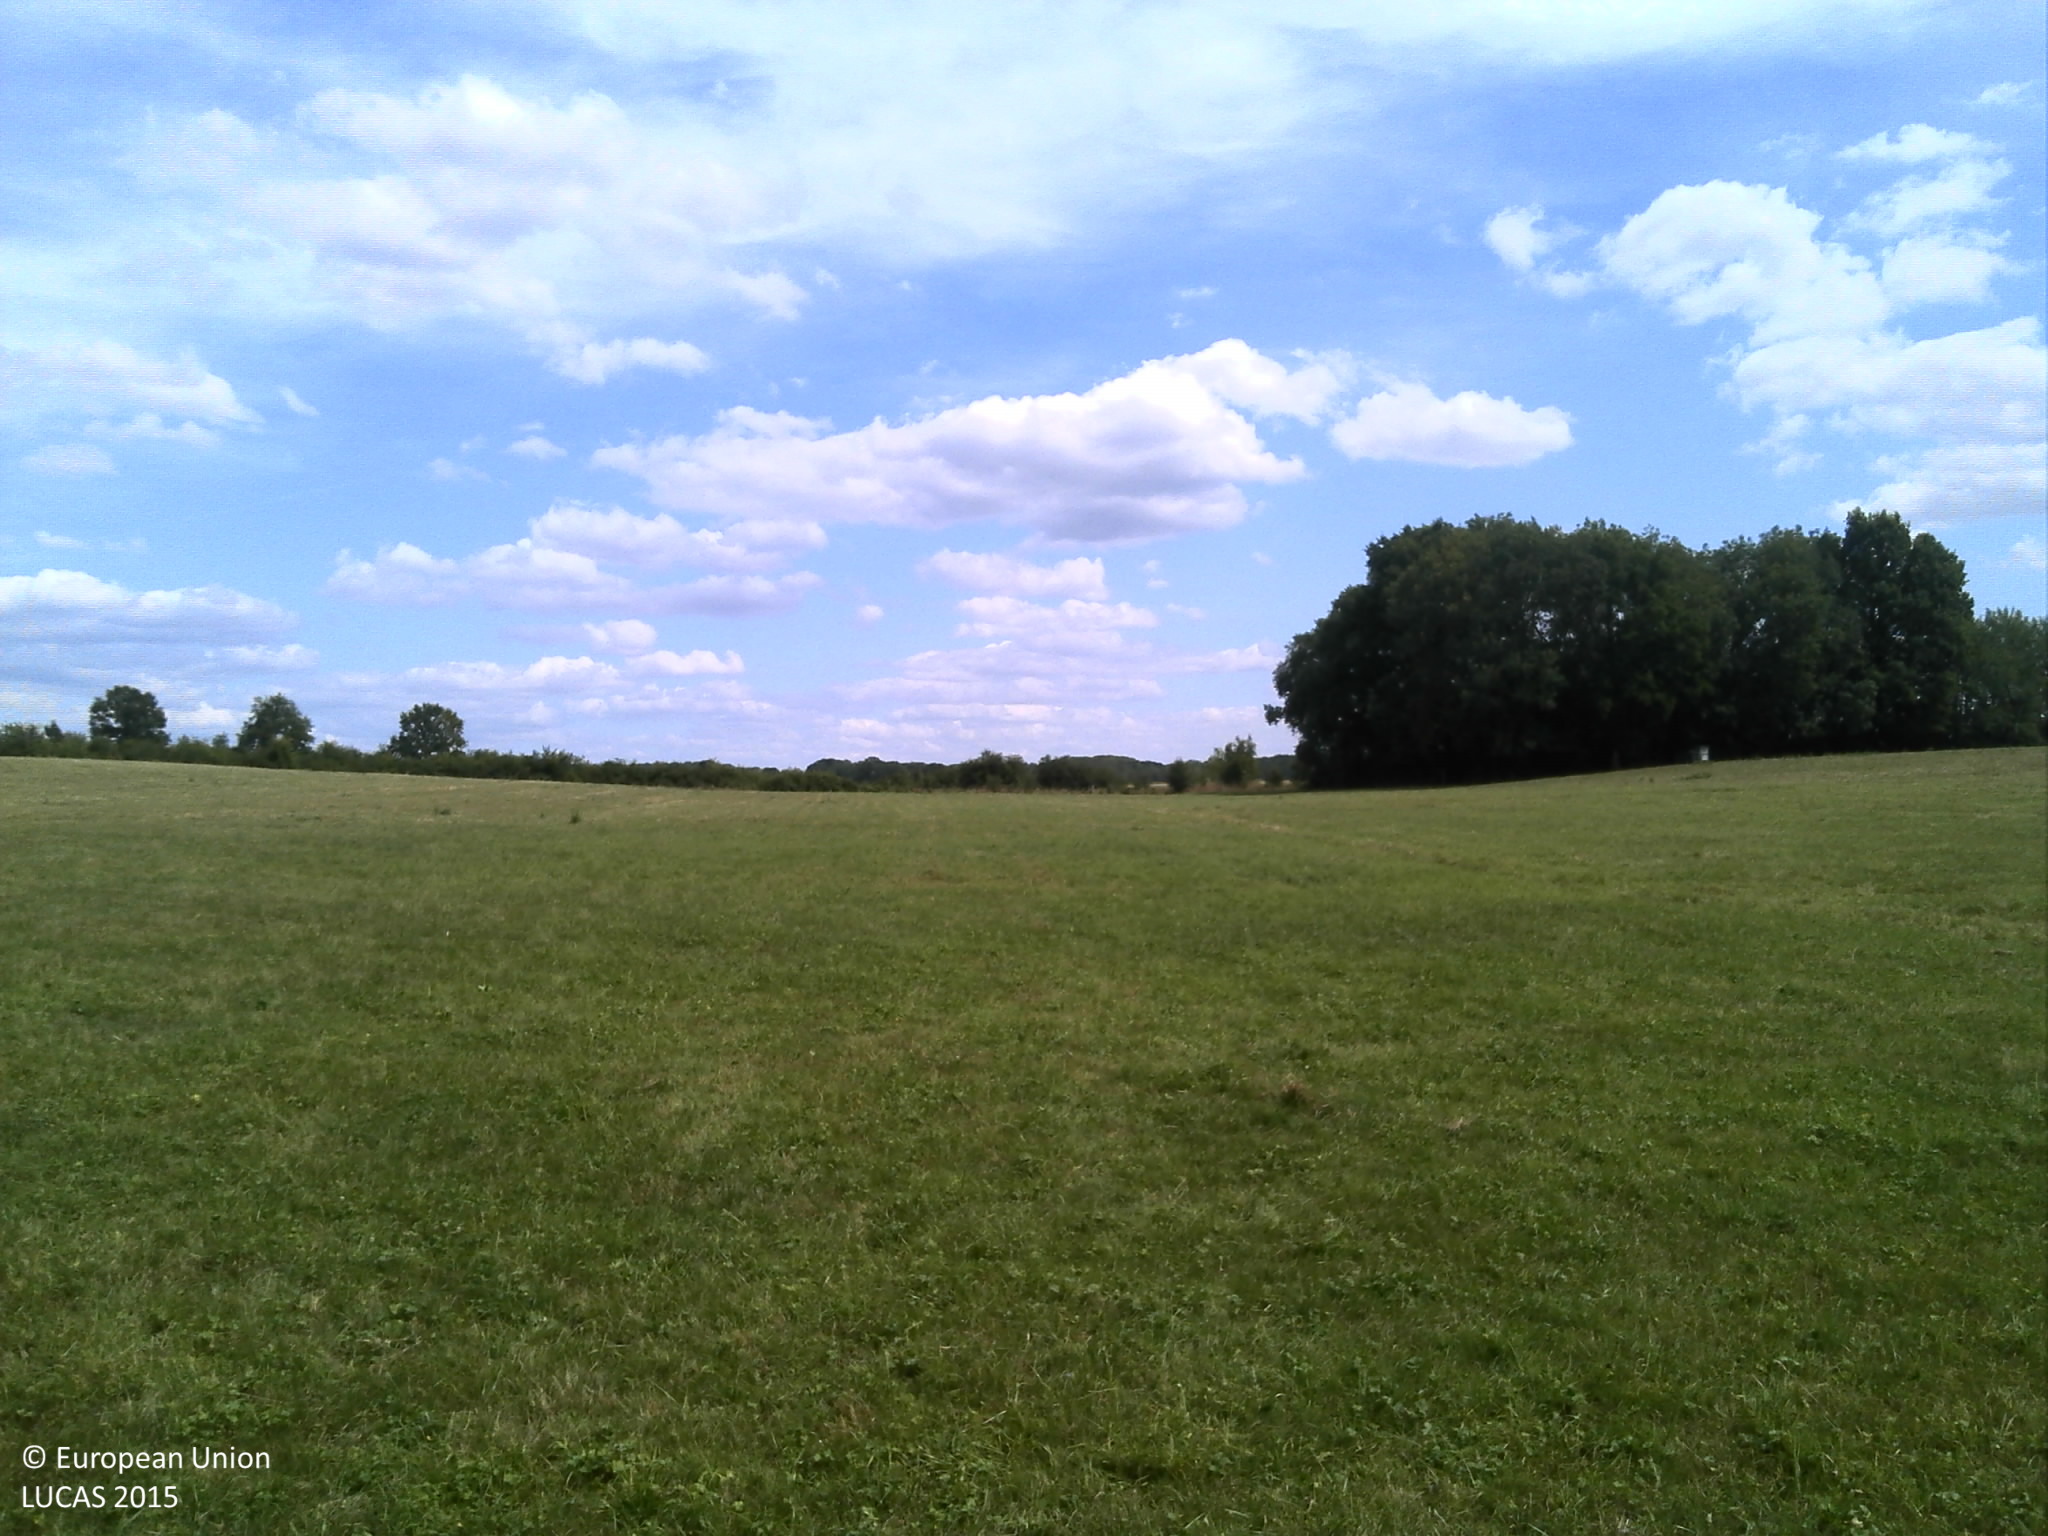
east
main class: Grassland
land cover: Grassland without tree/shrub cover
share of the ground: > 75 %
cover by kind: herbaceous plants 100 %
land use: Agriculture (excluding fallow land and kitchen gardens)
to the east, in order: Grassland without tree/shrub cover; Fences; Managed hedges; Grassland without tree/shrub cover
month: July
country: FR
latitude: 49.5333
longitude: 4.5939
